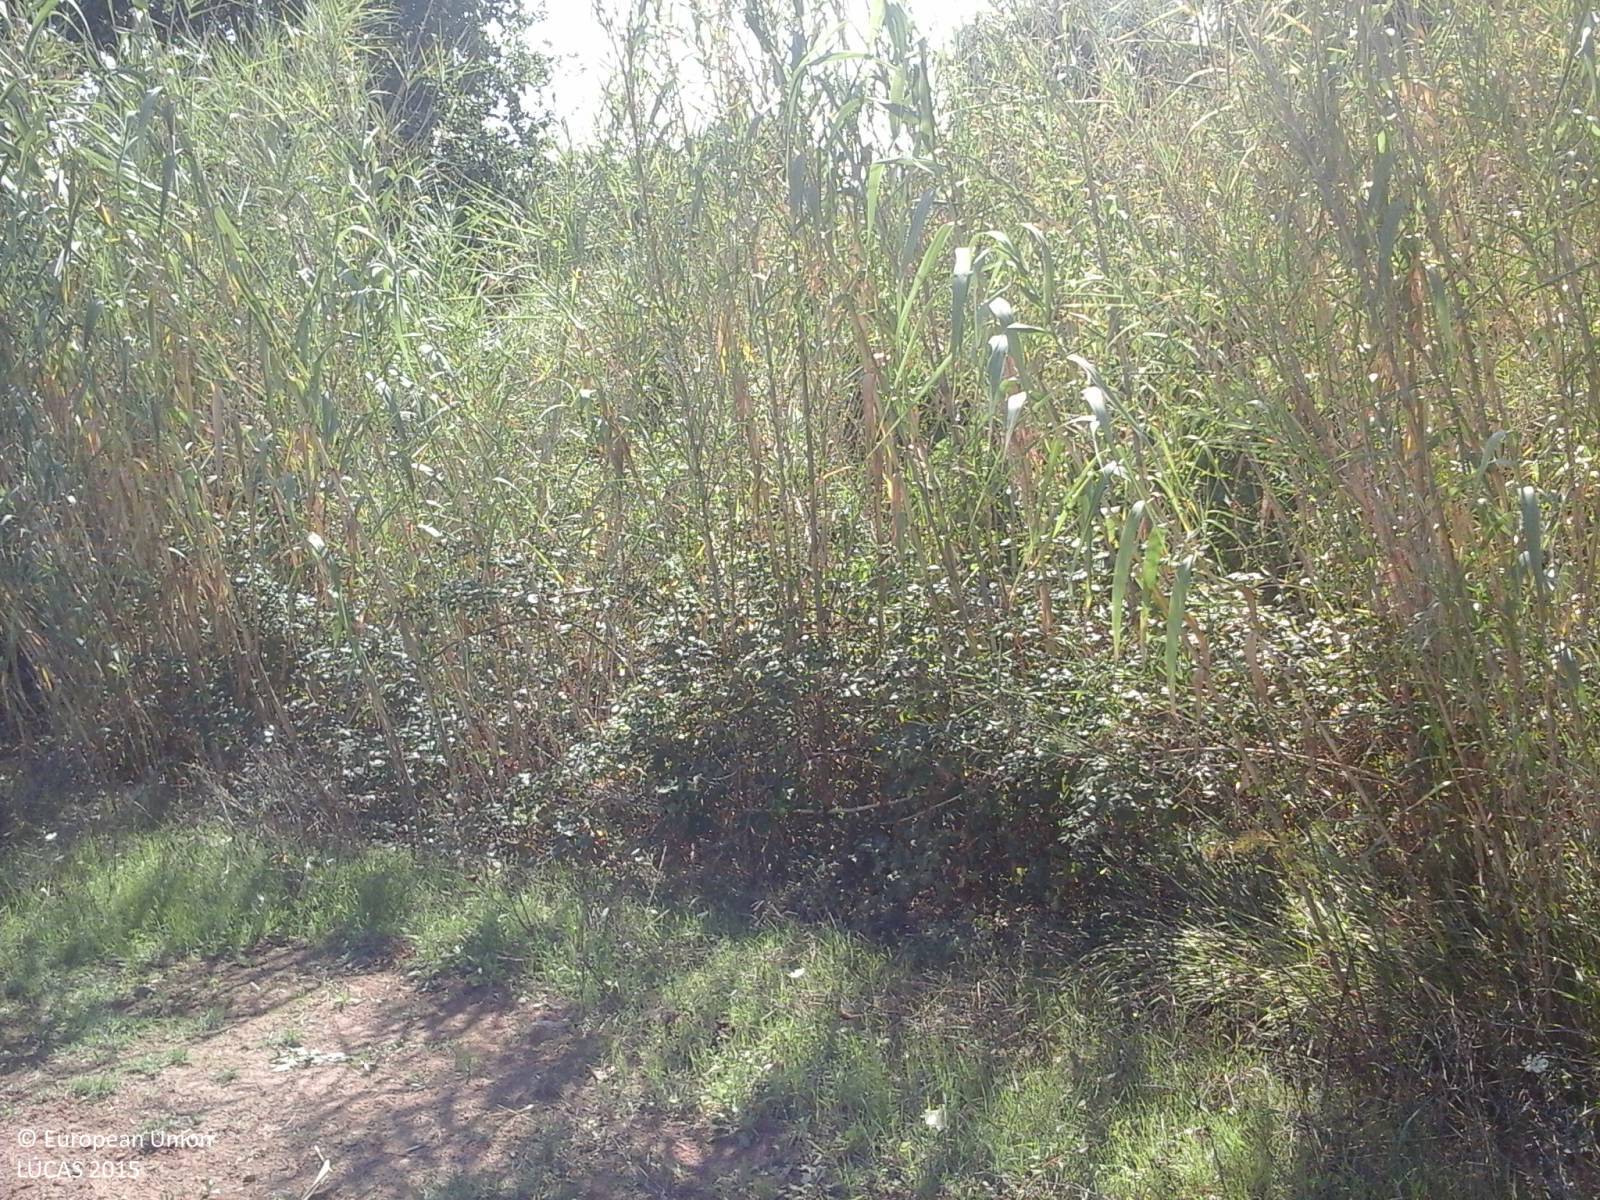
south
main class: Cropland
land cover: Vineyards
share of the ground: > 75 %
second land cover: Other bare soil
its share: > 75 %
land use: Agriculture (excluding fallow land and kitchen gardens)
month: September
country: IT
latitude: 42.3566
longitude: 12.3110
